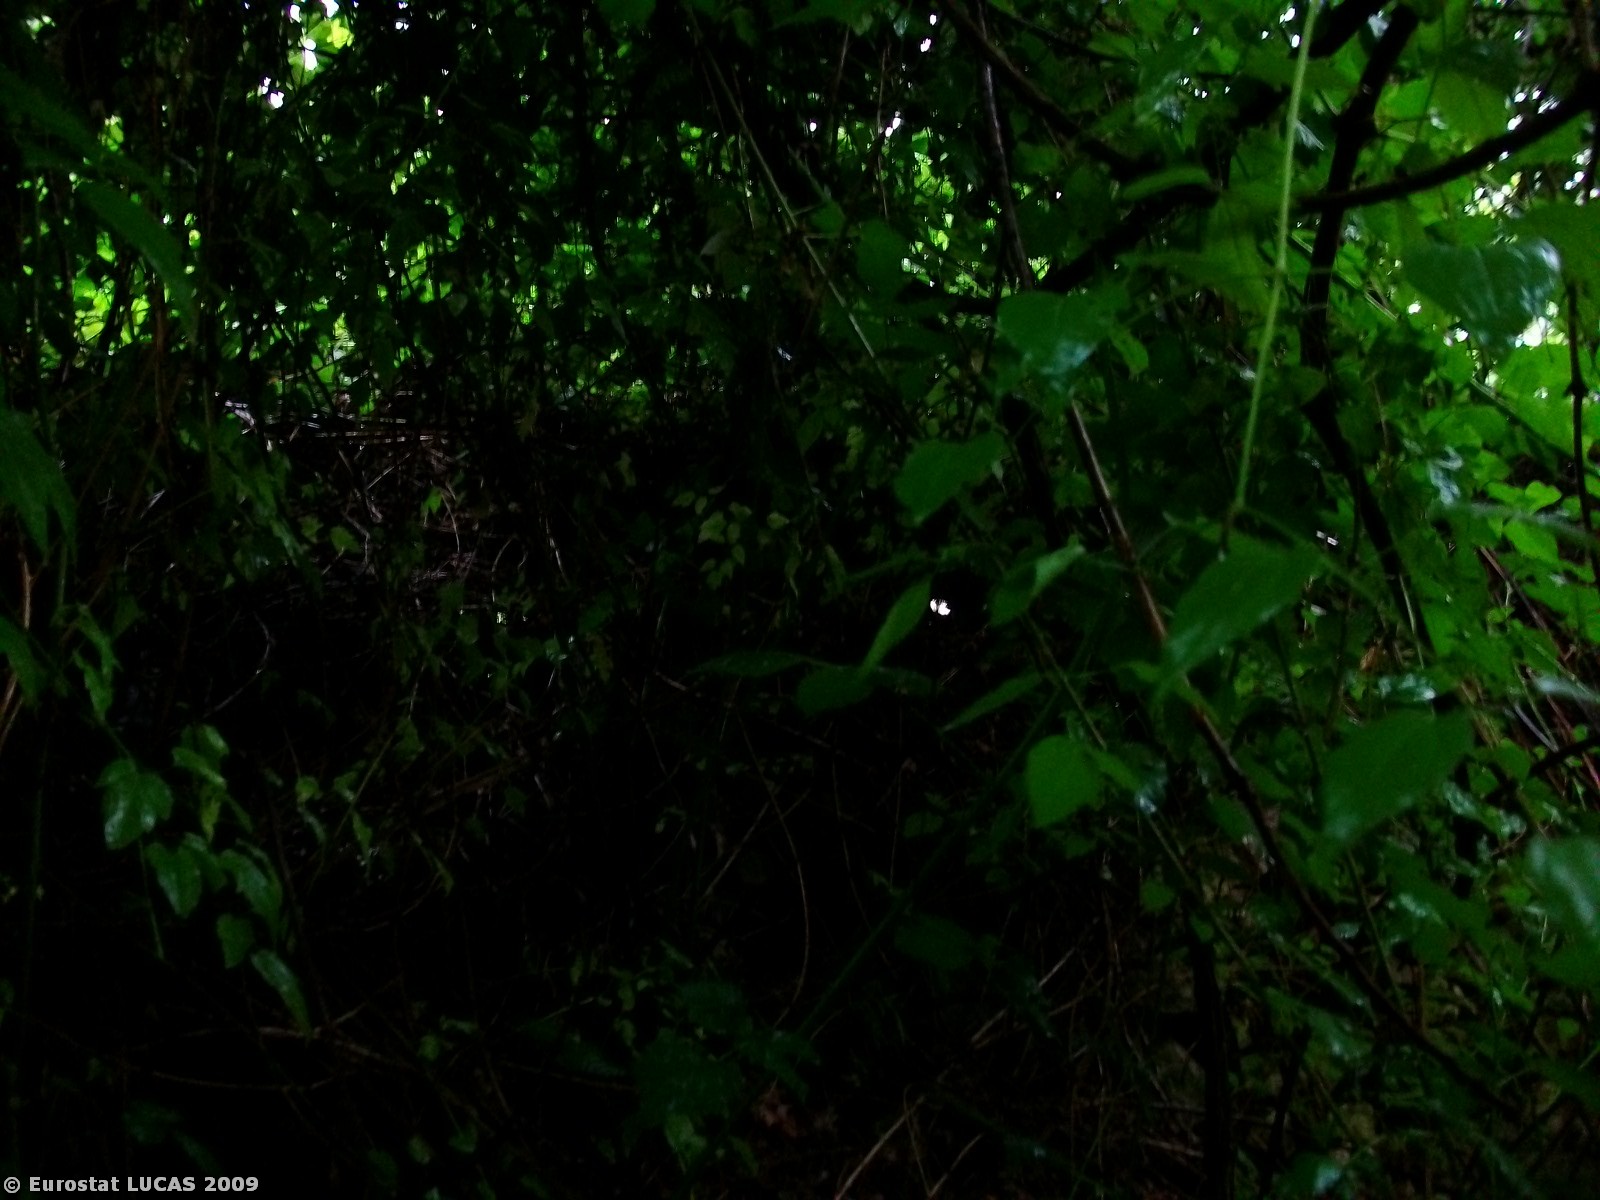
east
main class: Woodland
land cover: Broadleaved woodland
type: thermophilous deciduous forest
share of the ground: > 75 %
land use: Forestry
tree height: > 5 m
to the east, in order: Broadleaved woodland; Grassland with sparse tree/shrub cover; Abandoned hedges; Grassland without tree/shrub cover; Broadleaved woodland; Grassland without tree/shrub cover; Fences; Broadleaved woodland; Fences; Broadleaved woodland; Spontaneously vegetated surfaces; Broadleaved woodland
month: June
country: GR
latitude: 41.3503
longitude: 24.9737
